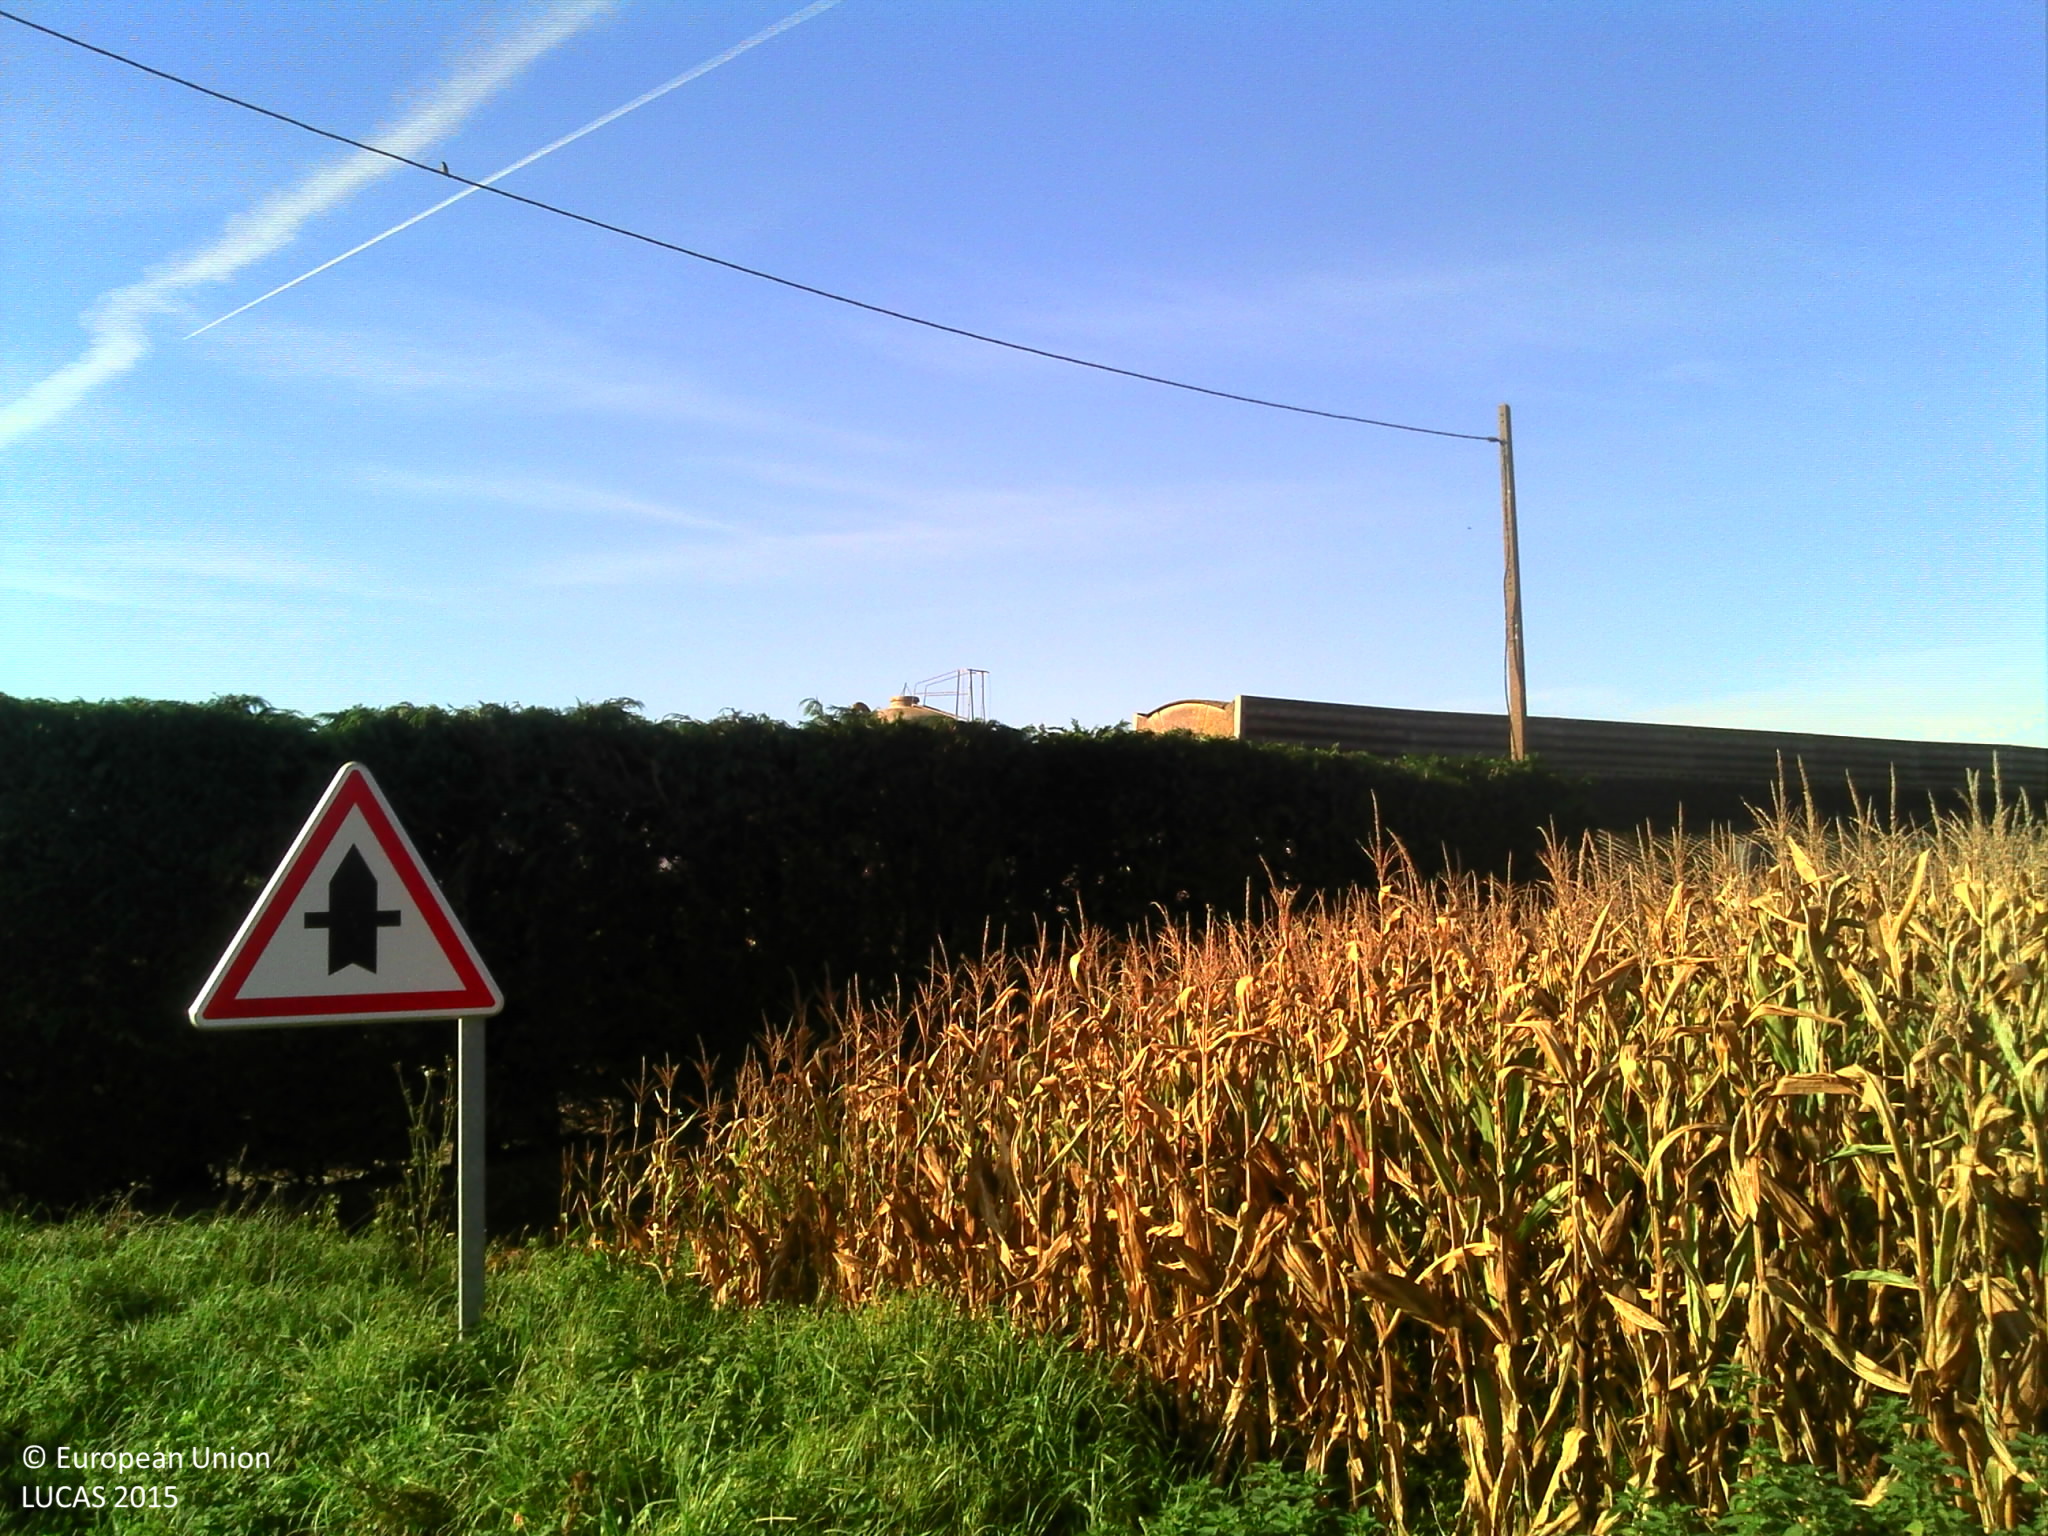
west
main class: Cropland
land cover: Maize
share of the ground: > 75 %
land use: Agriculture (excluding fallow land and kitchen gardens)
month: October
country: FR
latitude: 47.9643
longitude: -2.9648
